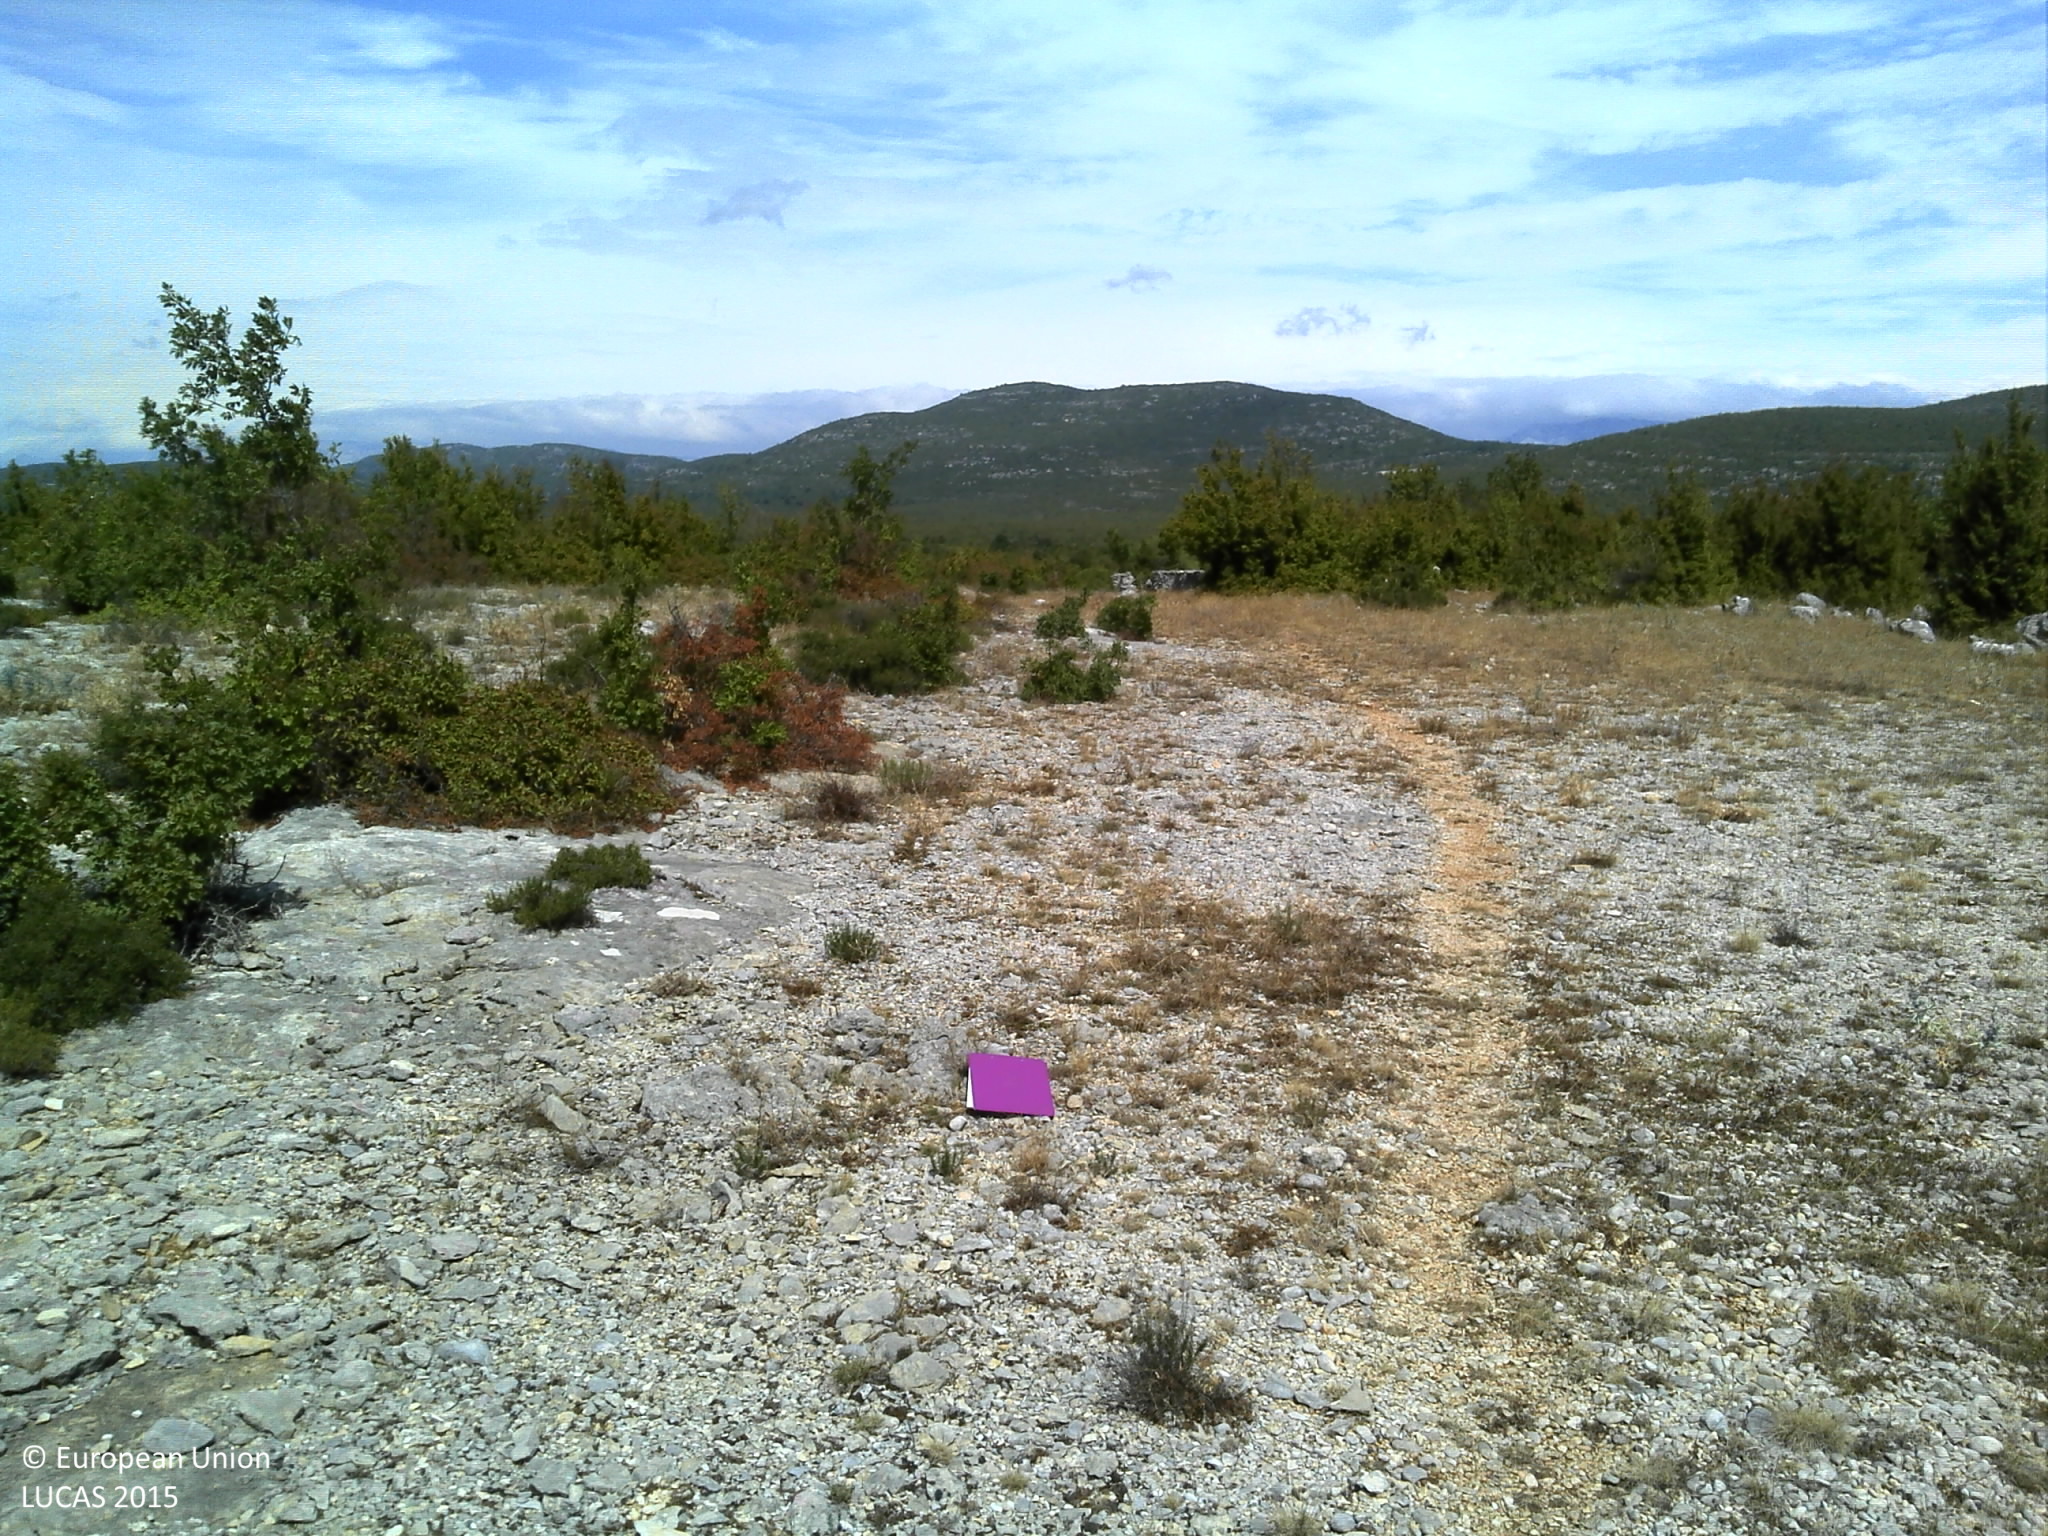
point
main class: Shrubland
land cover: Shrubland without tree cover
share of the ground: 25 - 50 %
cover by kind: shrubs 30 %, unconsolidated bare surface 30 %, herbaceous plants 20 %, consolidated bare surface 20 %
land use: Abandoned areas
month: August
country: HR
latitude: 44.0771
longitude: 15.8487
